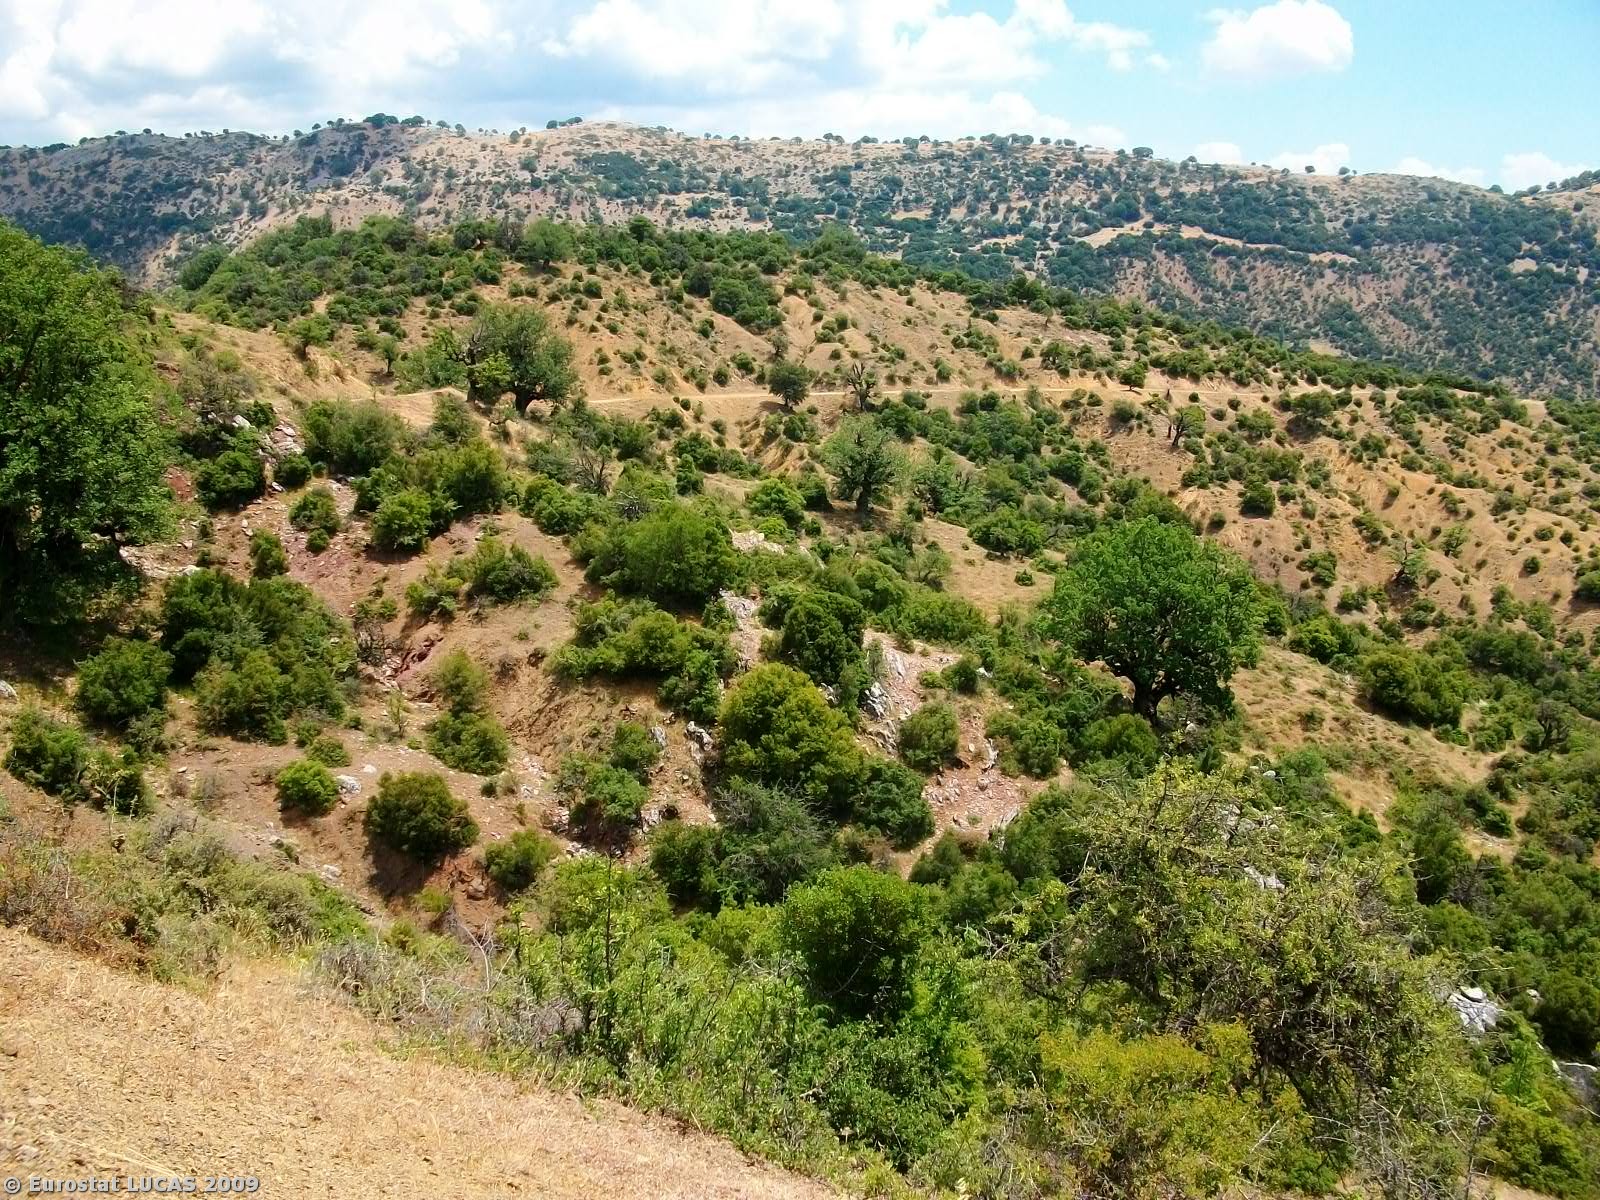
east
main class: Shrubland
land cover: Shrubland with sparse tree cover
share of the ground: 50 - 75 %
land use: Agriculture (excluding fallow land and kitchen gardens)
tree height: < 5 m
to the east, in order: Shrubland with sparse tree cover; Rivers and streams; Shrubland with sparse tree cover; Tracks; Grassland without tree/shrub cover; Shrubland with sparse tree cover
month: July
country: GR
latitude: 38.4660
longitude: 22.1560
